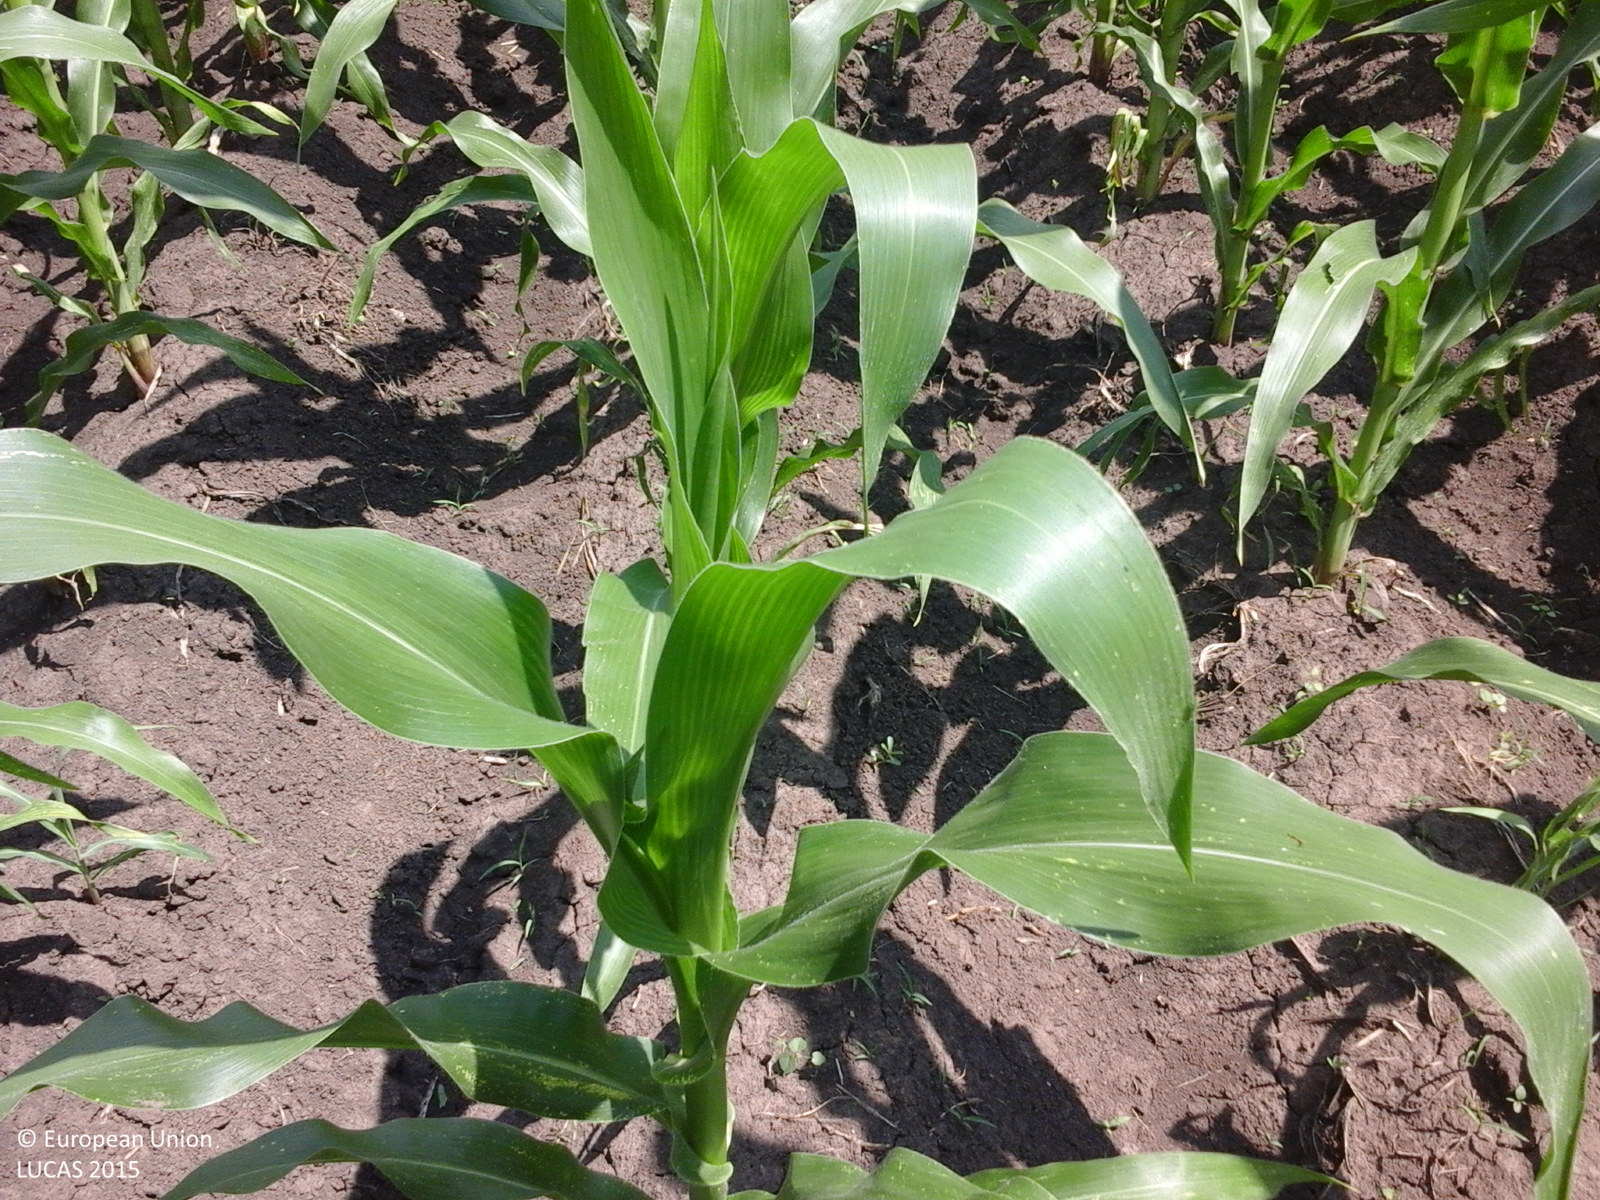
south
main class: Cropland
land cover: Maize
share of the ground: > 75 %
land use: Agriculture (excluding fallow land and kitchen gardens)
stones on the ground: < 10 %
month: July
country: RO
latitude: 43.9867
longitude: 25.4844
